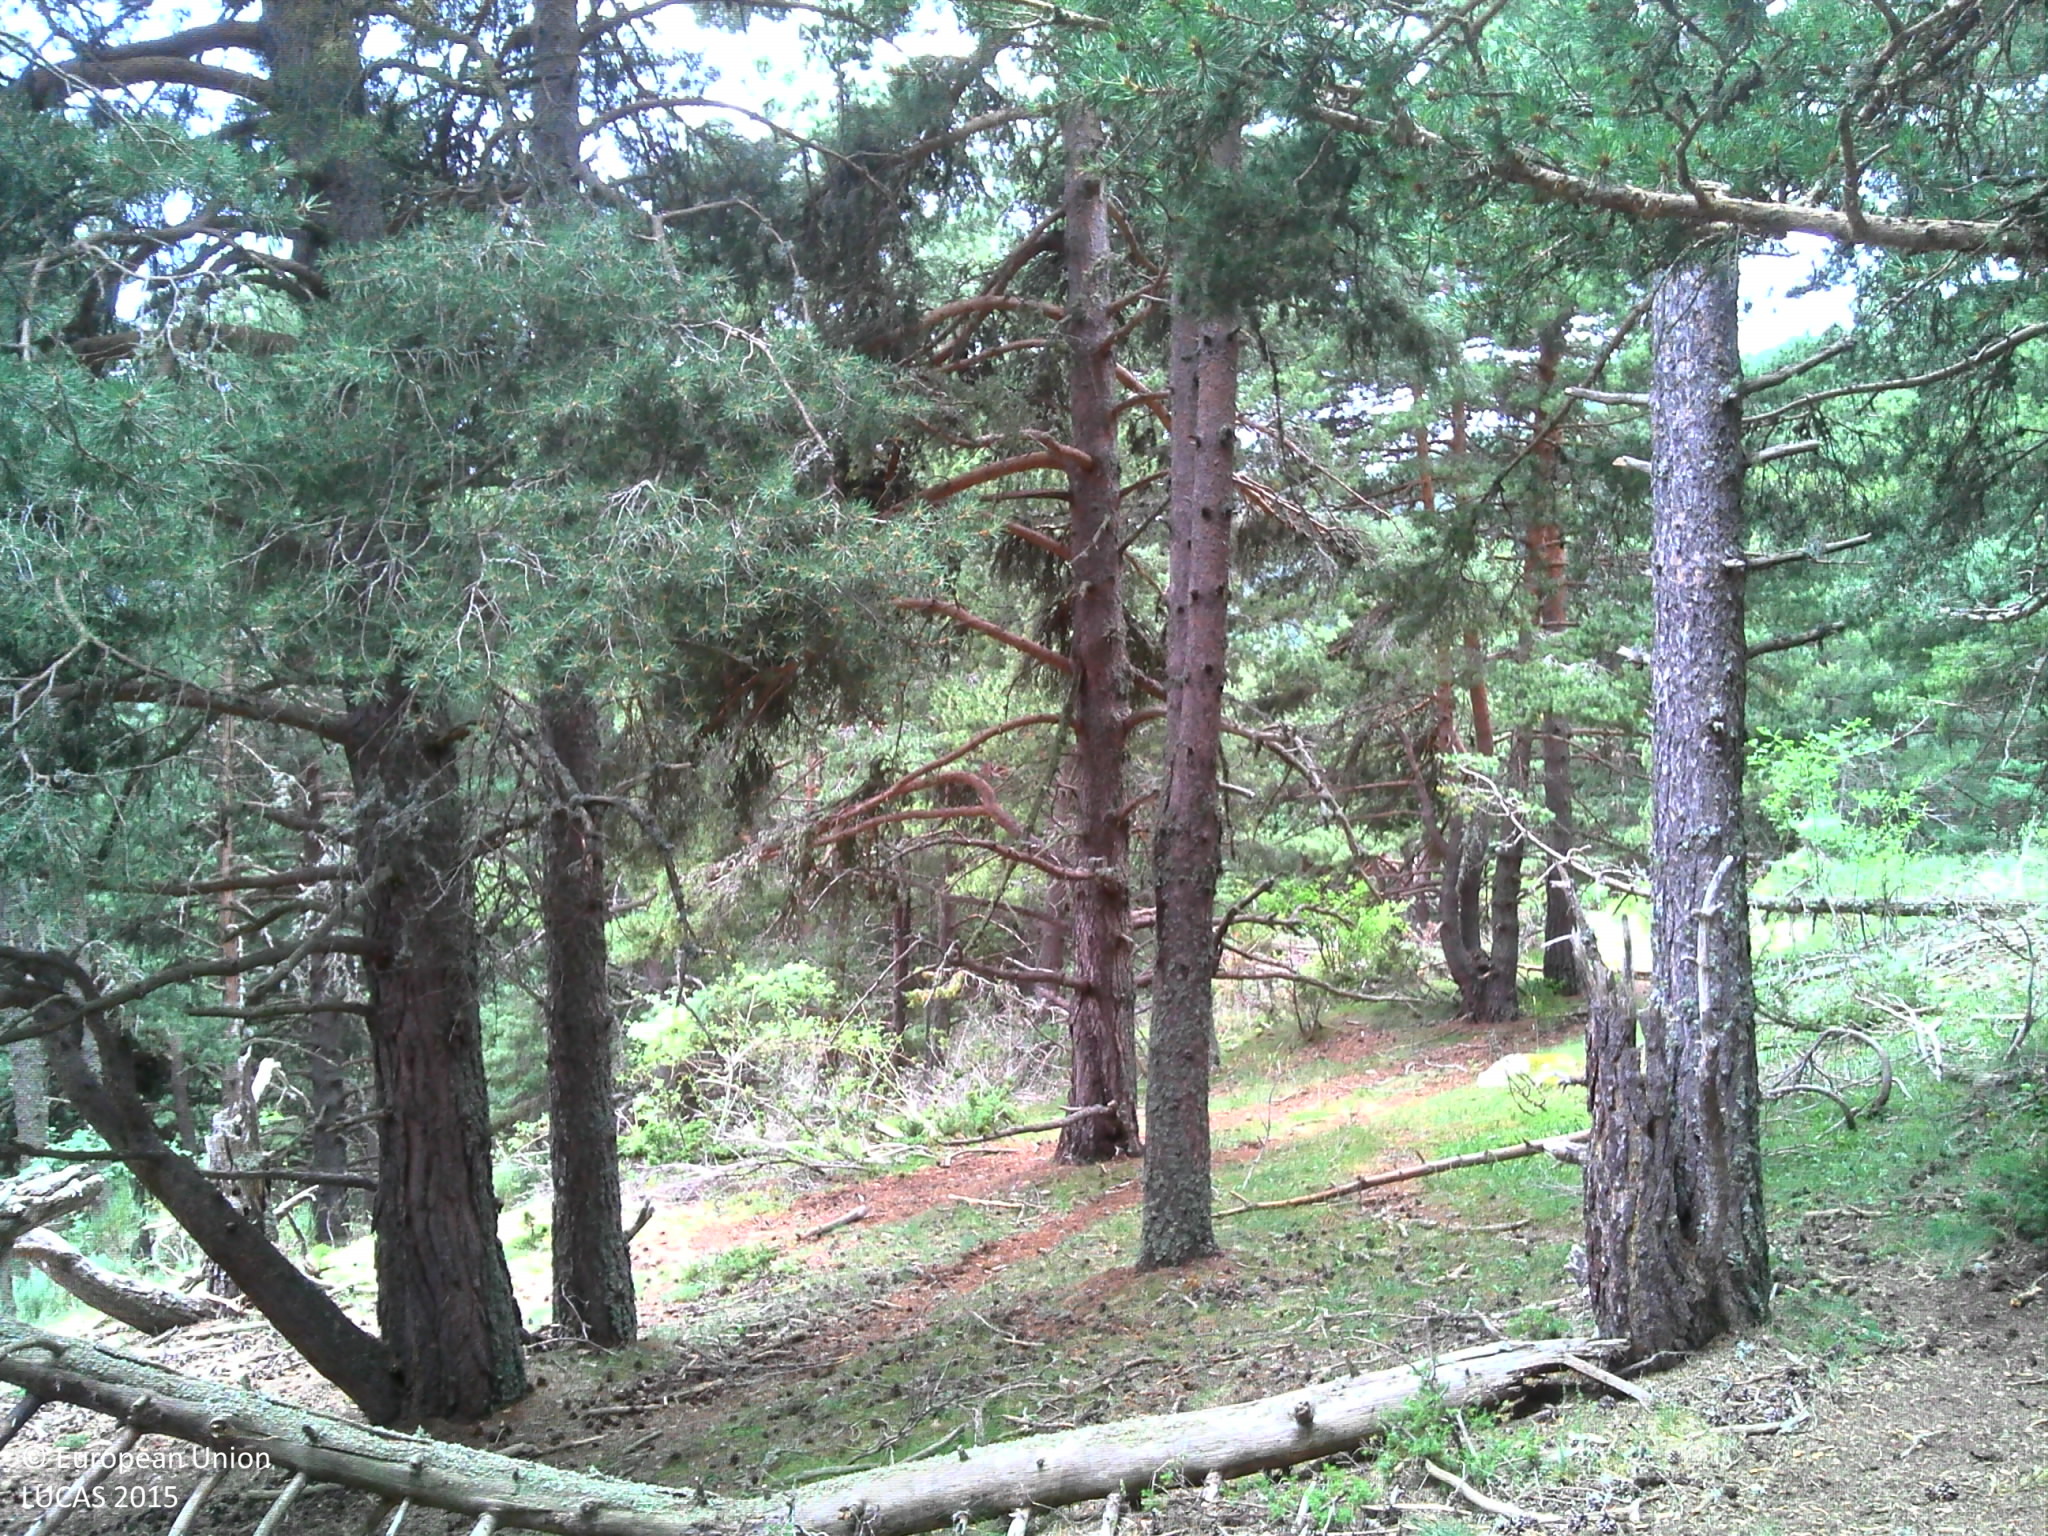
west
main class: Woodland
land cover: Pine dominated coniferous woodland
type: hemiboreal forest and nemoral coniferous forest and mixed broadleaved-coniferous forest
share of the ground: > 75 %
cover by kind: coniferous forest trees 80 %, shrubs 10 %, herbaceous plants 10 %
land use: Agriculture (excluding fallow land and kitchen gardens)
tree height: > 5 m
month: July
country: FR
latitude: 42.6029
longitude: 2.1492
